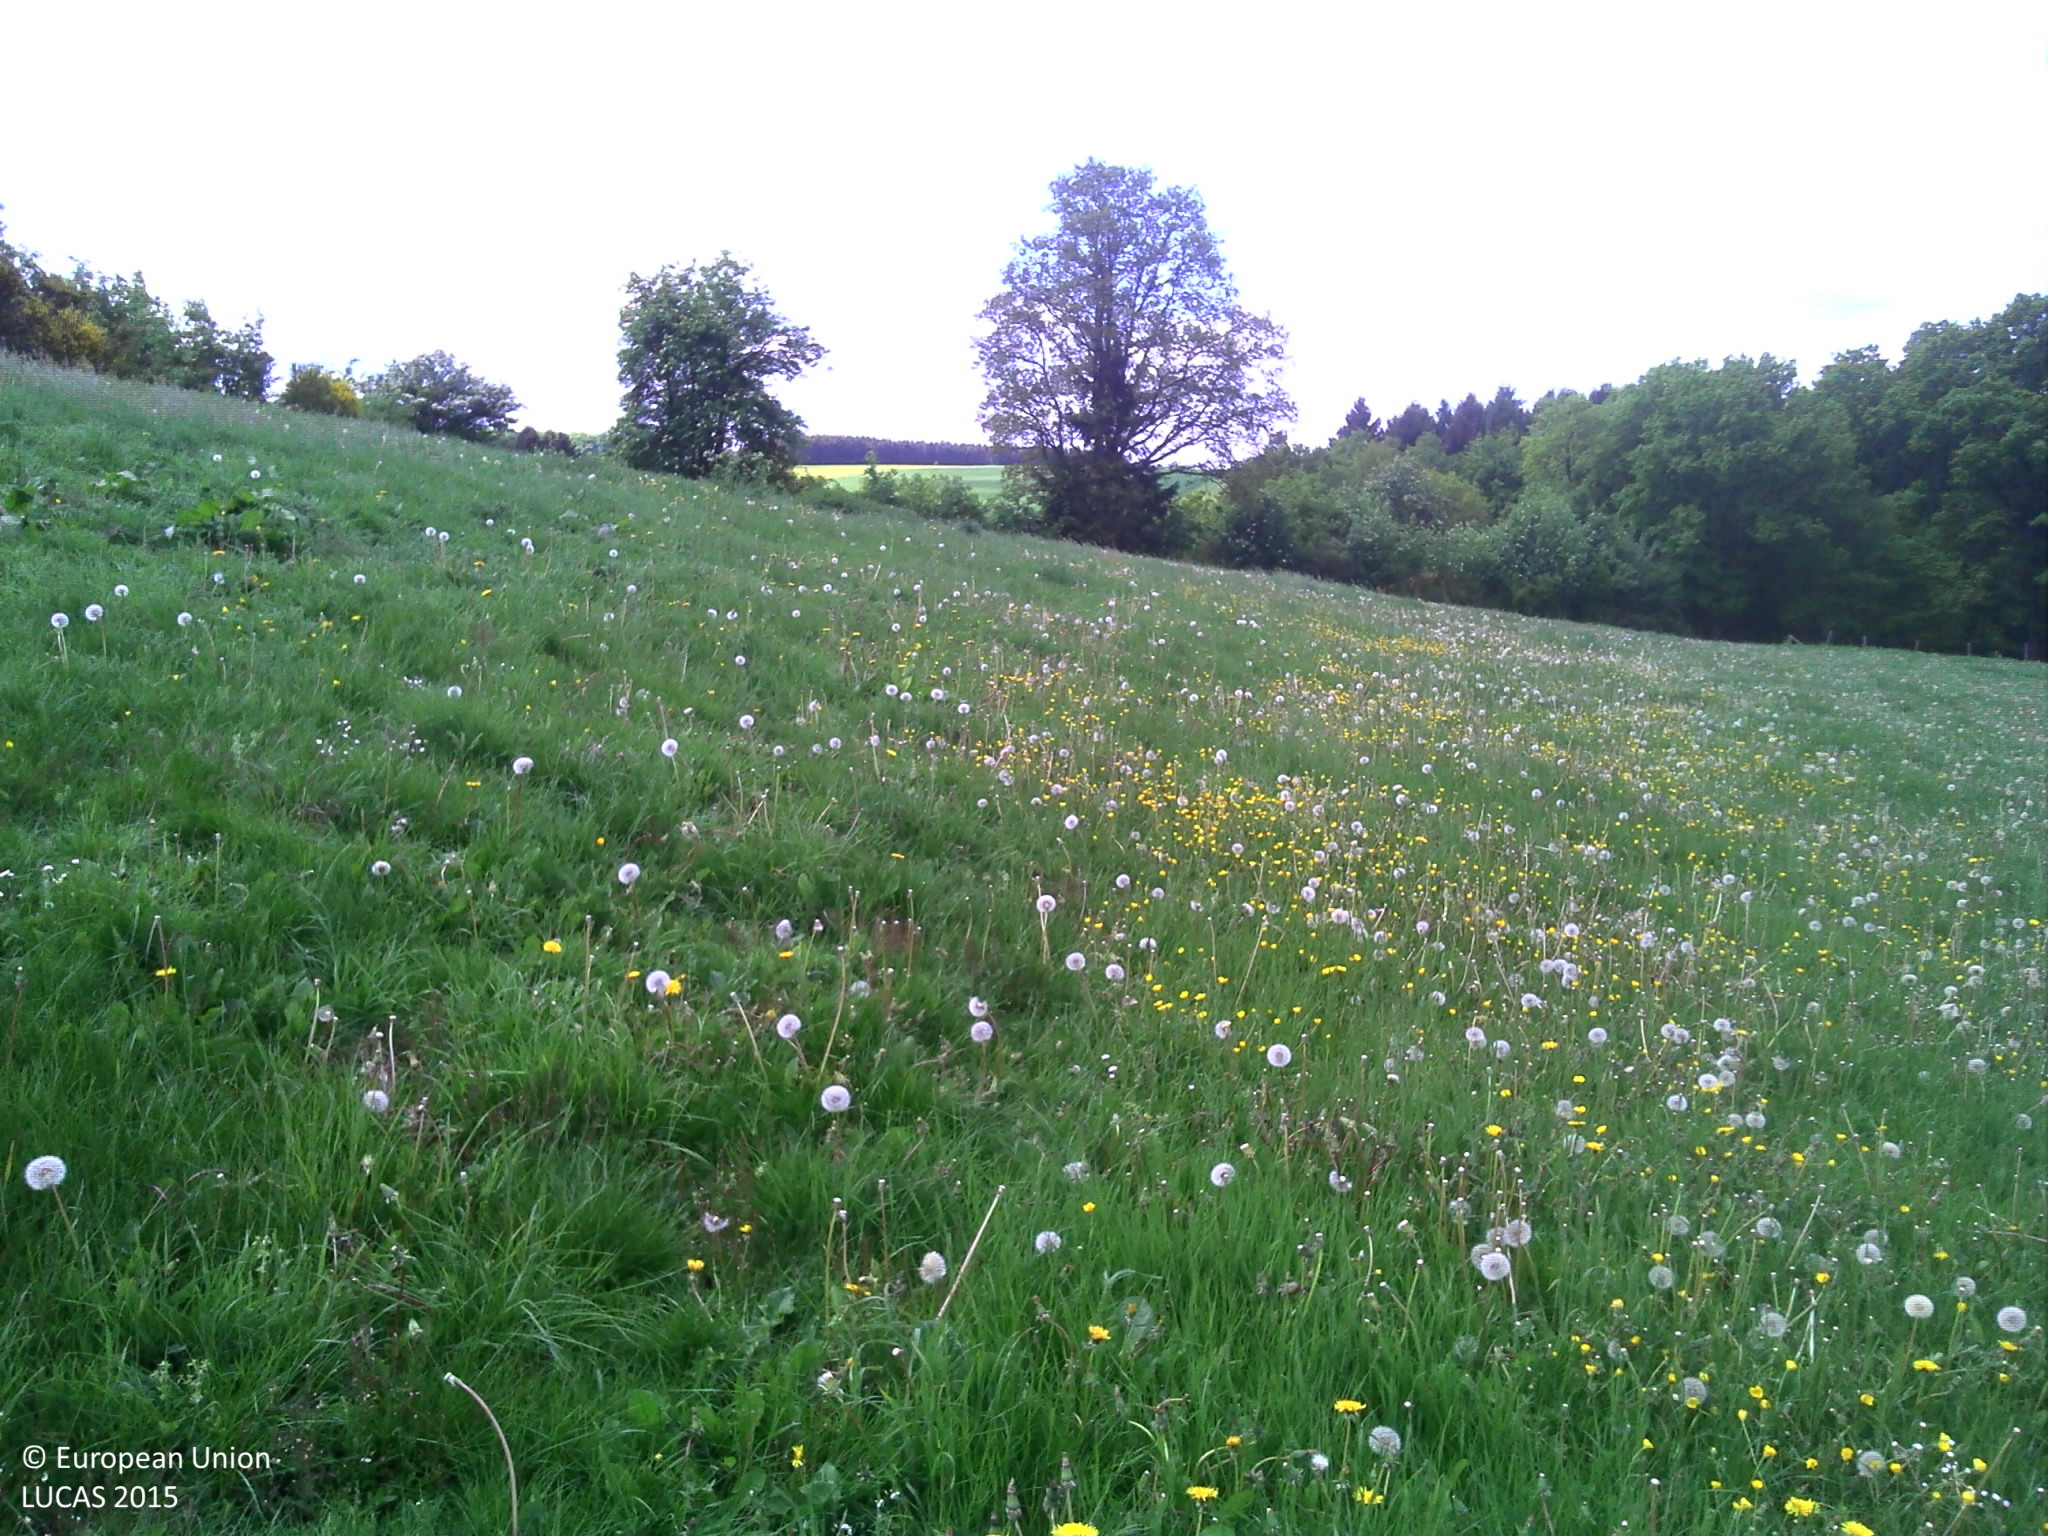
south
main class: Grassland
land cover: Grassland without tree/shrub cover
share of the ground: > 75 %
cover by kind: herbaceous plants 100 %
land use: Agriculture (excluding fallow land and kitchen gardens)
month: May
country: LU
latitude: 50.0588
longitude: 5.9622
